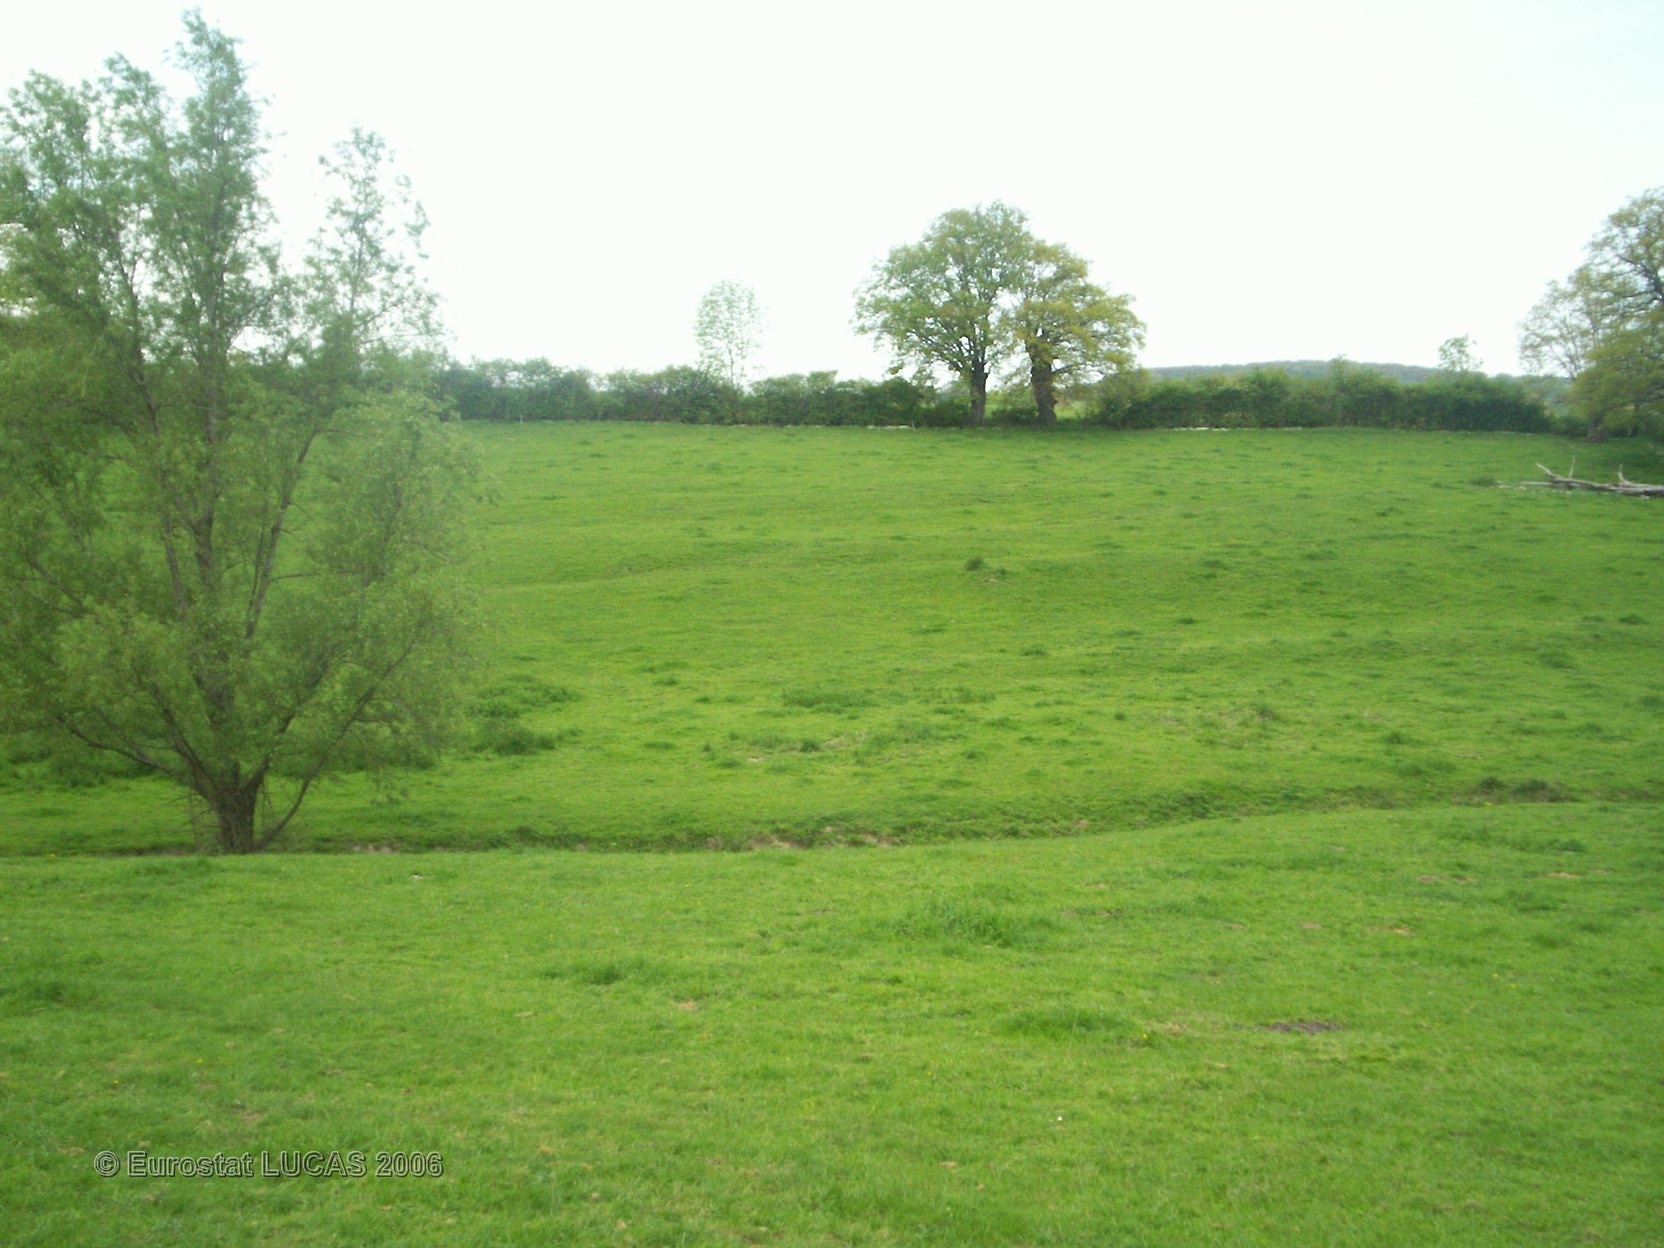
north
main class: Grassland
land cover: Grassland without tree/shrub cover
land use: Agriculture (excluding fallow land and kitchen gardens)
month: May
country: FR
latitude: 46.4901
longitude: 3.1058
